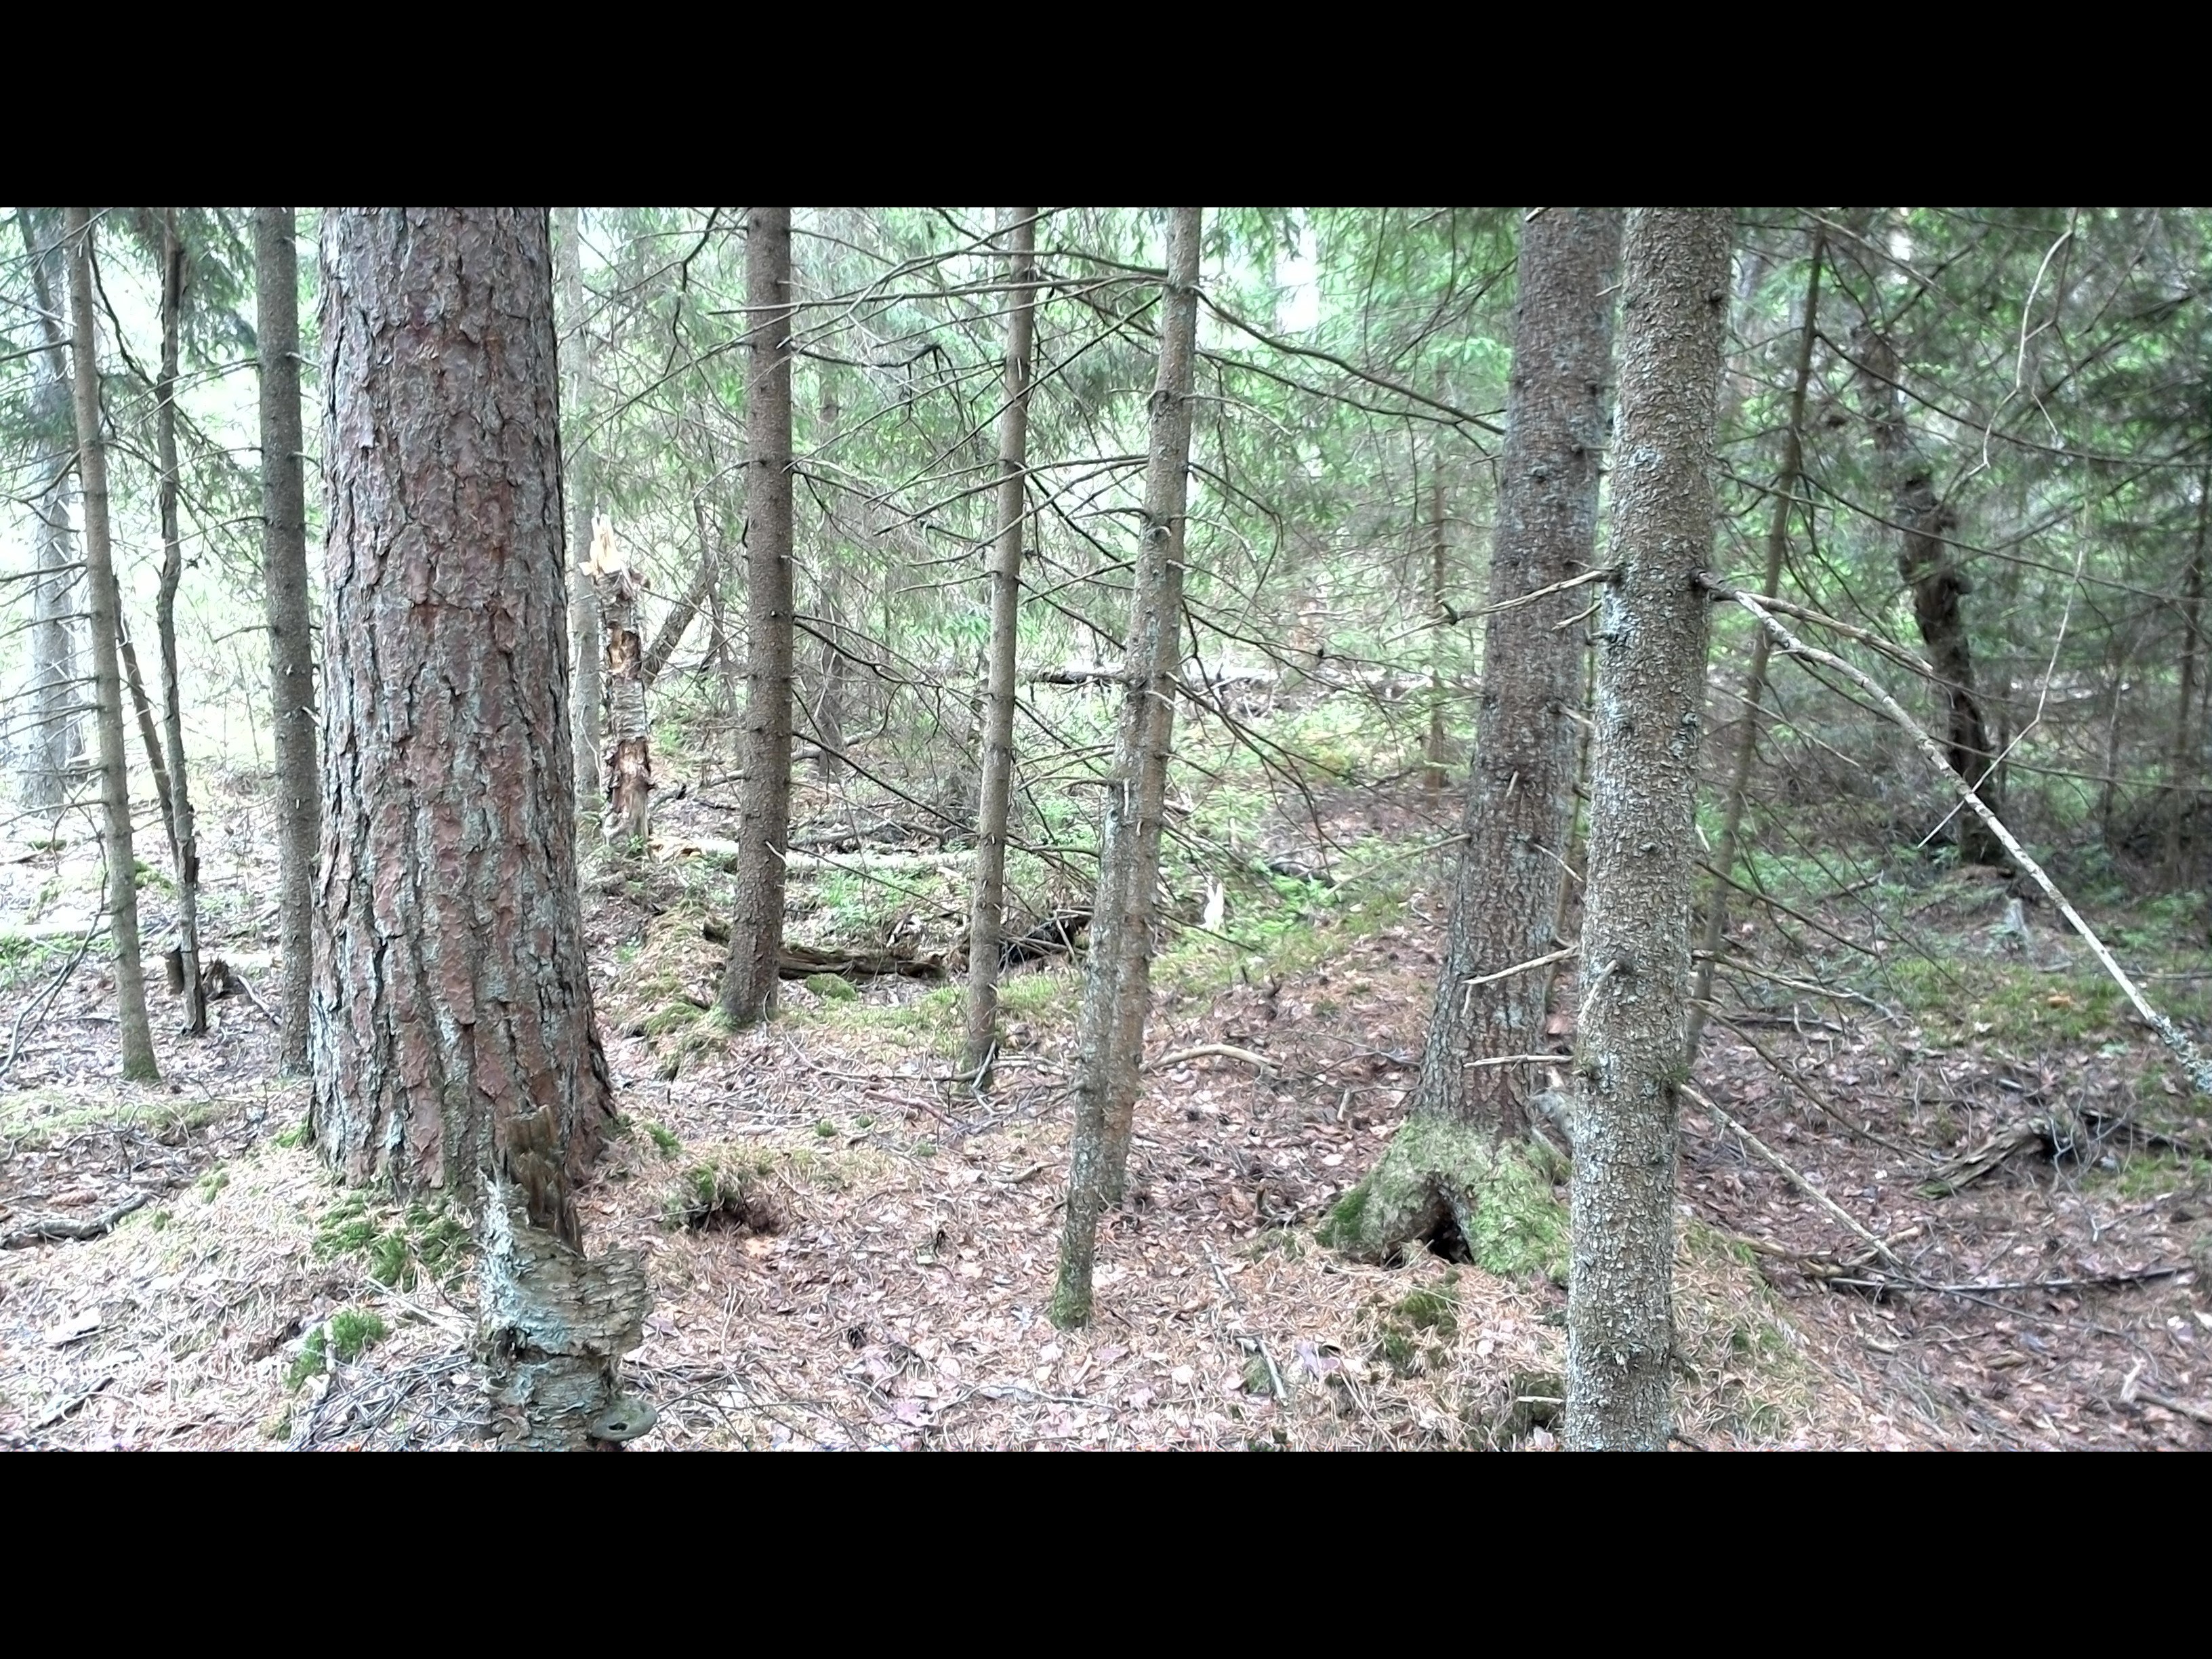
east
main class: Woodland
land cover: Spruce dominated coniferous woodland
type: boreal forest
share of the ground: 50 - 75 %
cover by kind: coniferous forest trees 75 %, lichens and mosses 15 %, shrubs 10 %
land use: Forestry
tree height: > 5 m
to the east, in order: Spruce dominated coniferous woodland; Tracks; Spruce dominated coniferous woodland
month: July
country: SE
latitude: 56.4093
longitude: 15.1360
